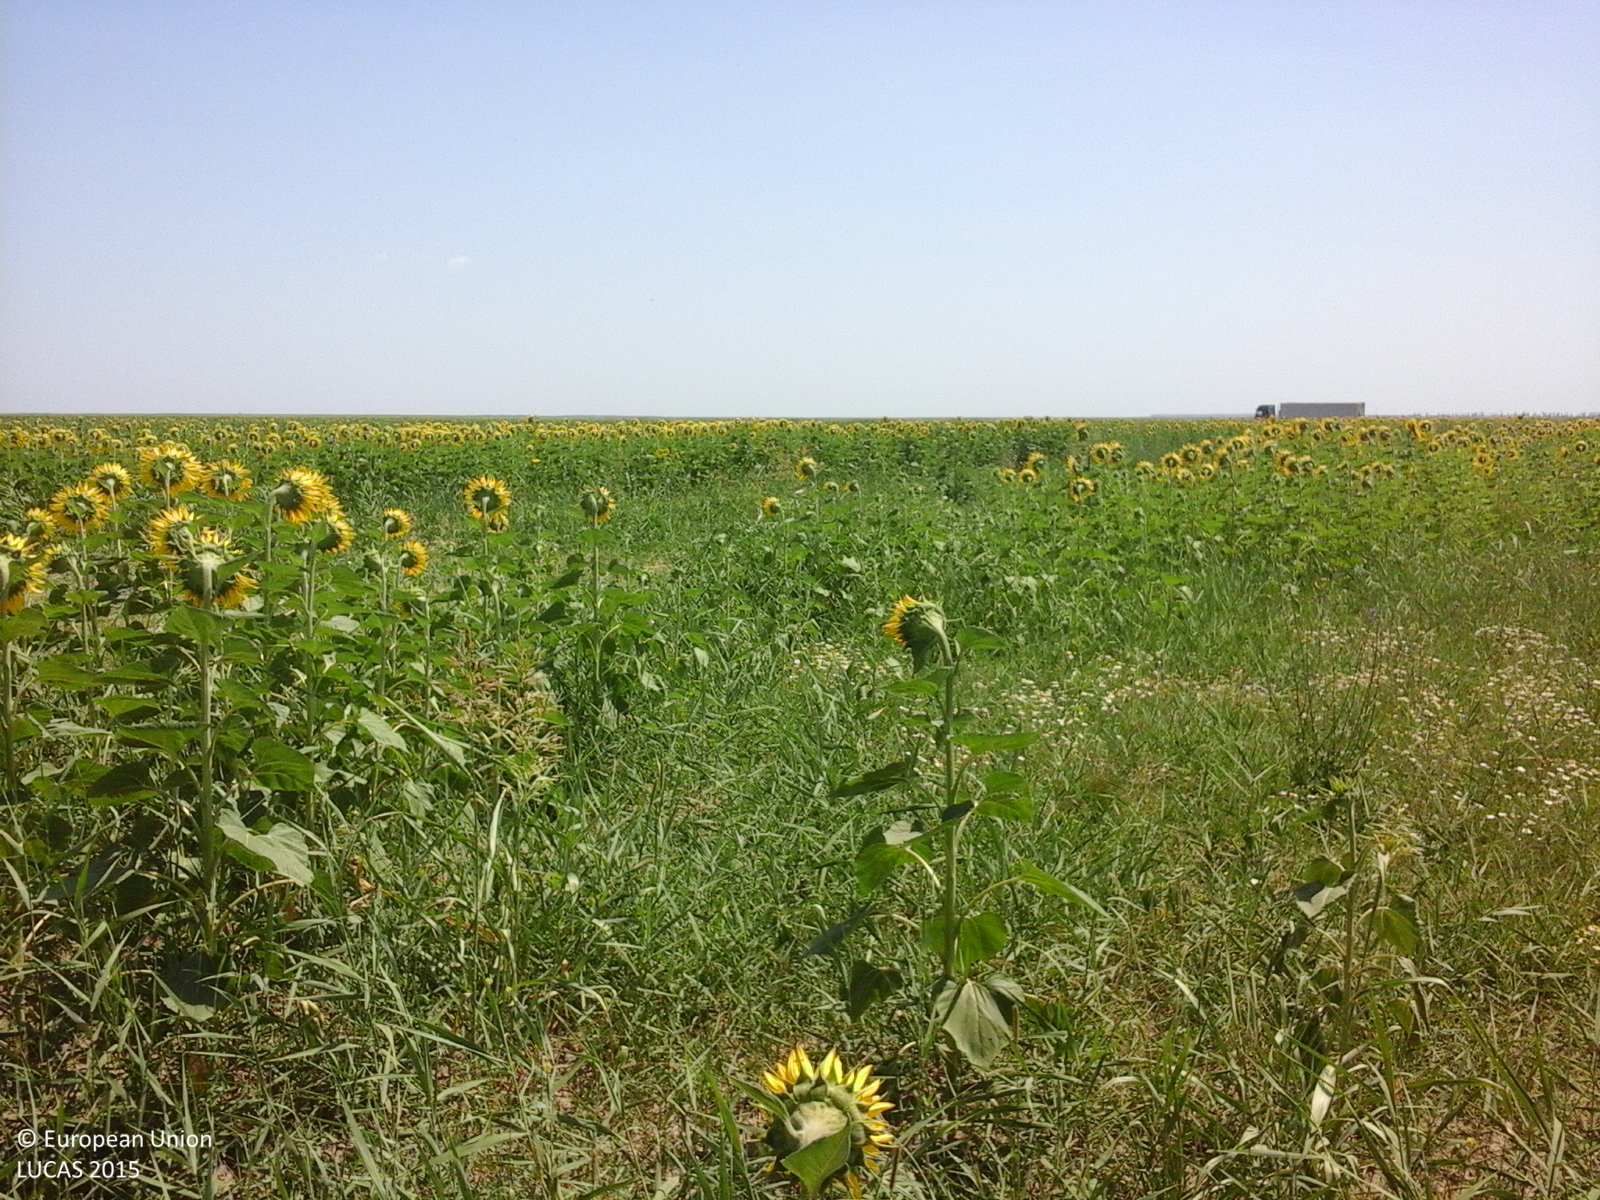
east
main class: Cropland
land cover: Sunflower
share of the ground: > 75 %
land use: Agriculture (excluding fallow land and kitchen gardens)
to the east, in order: Sunflower
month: July
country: RO
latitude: 45.0361
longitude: 26.6394
